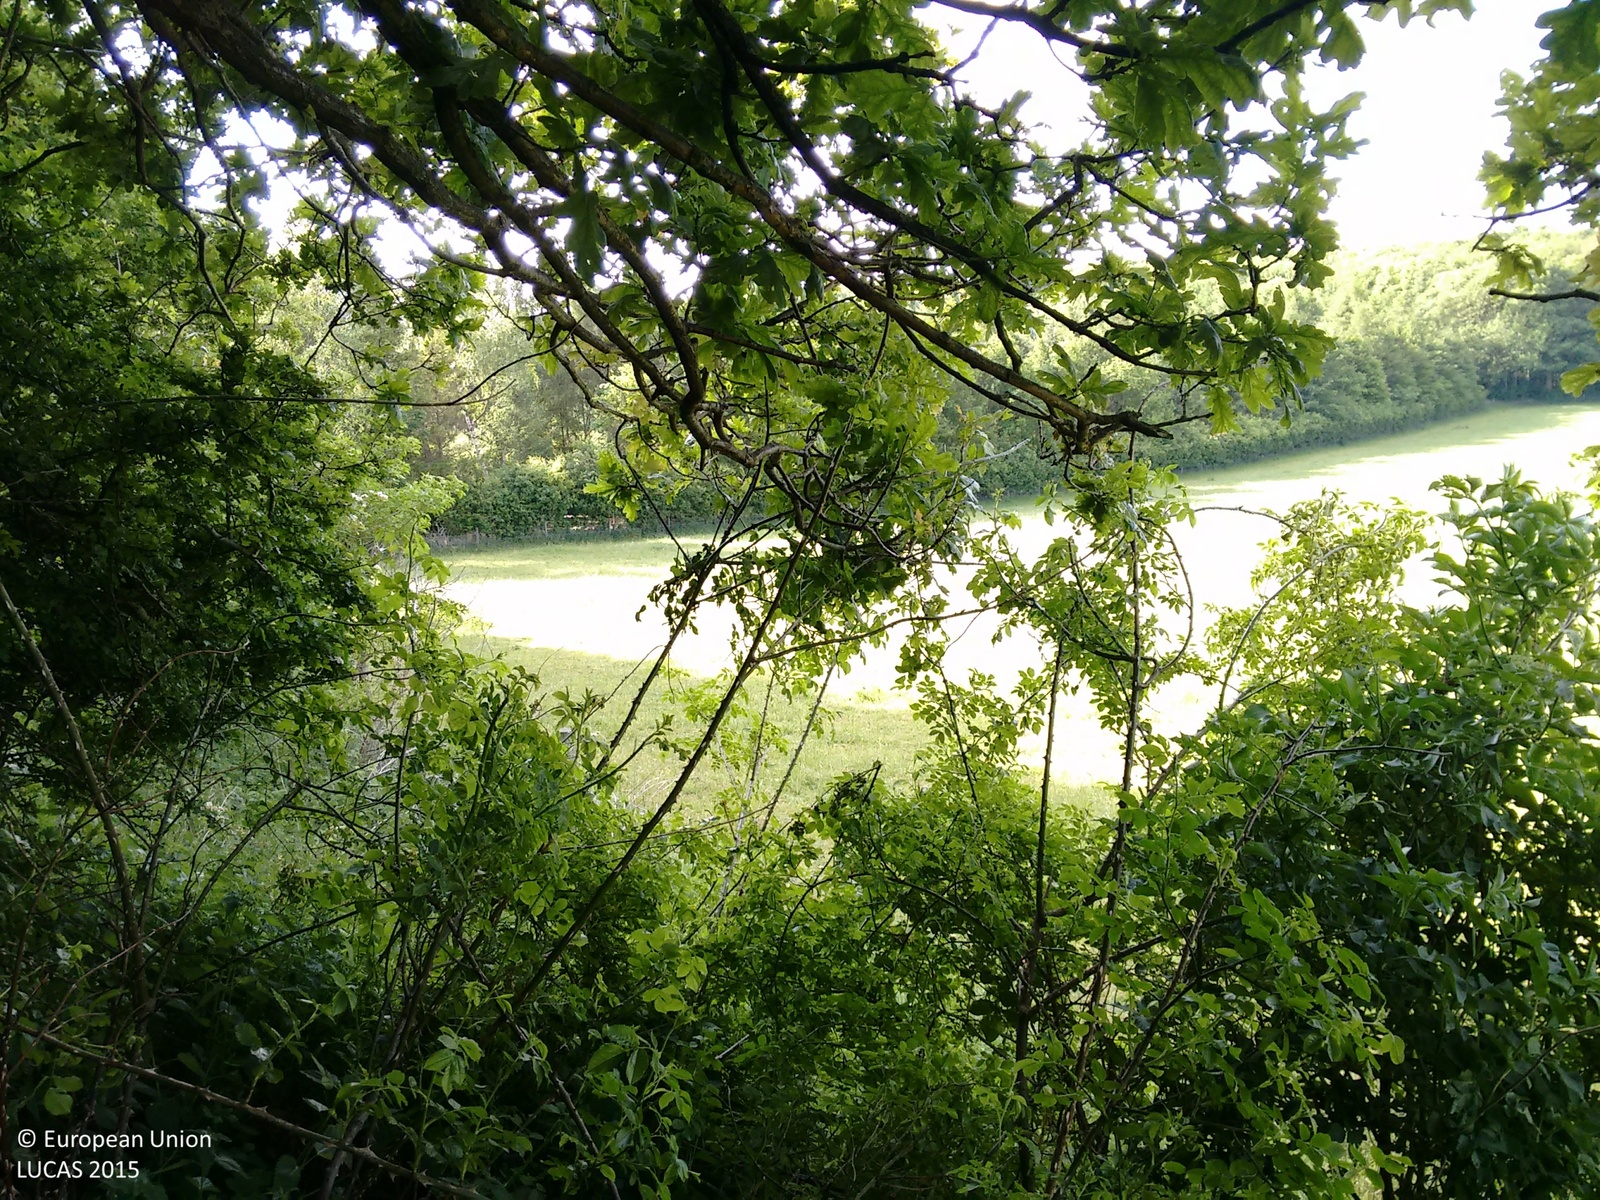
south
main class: Grassland
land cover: Grassland without tree/shrub cover
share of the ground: > 75 %
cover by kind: herbaceous plants 100 %
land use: Agriculture (excluding fallow land and kitchen gardens)
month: June
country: GB
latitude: 53.8890
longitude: -1.2907
